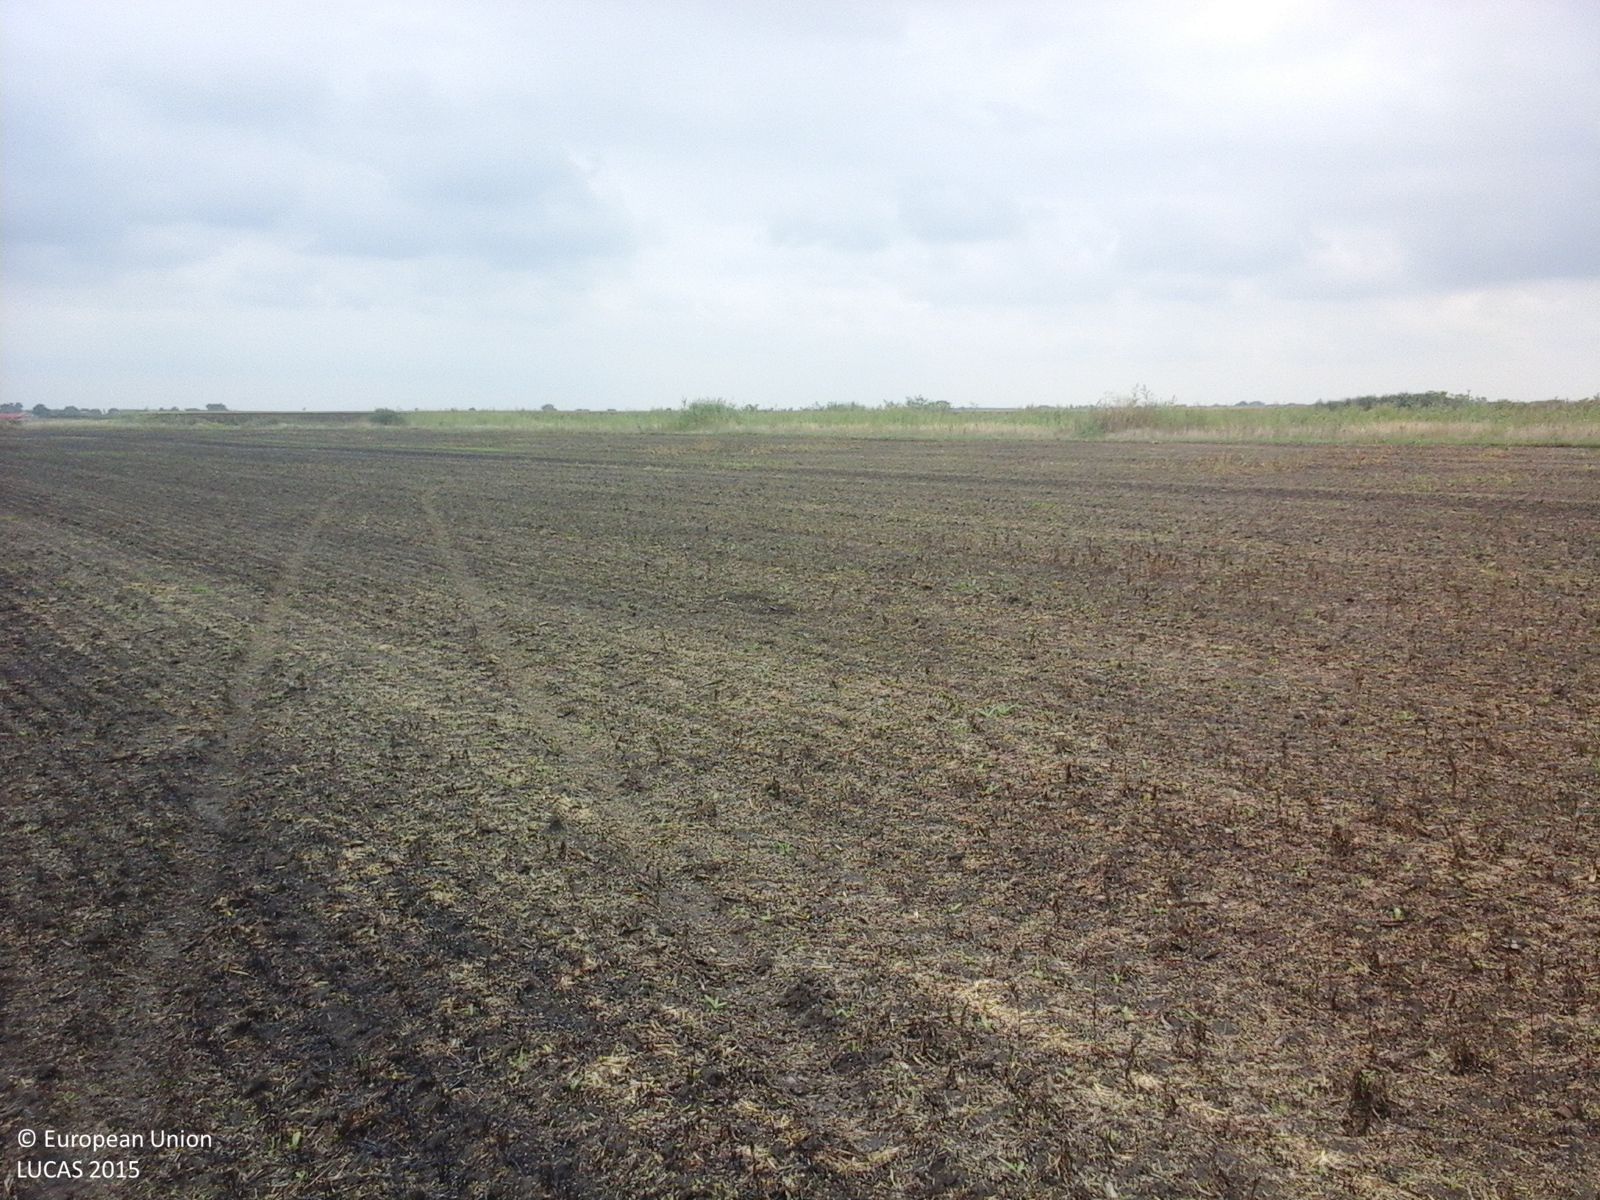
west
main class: Cropland
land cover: Common wheat
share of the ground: < 10 %
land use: Agriculture (excluding fallow land and kitchen gardens)
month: August
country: RO
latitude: 46.1417
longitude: 20.3147
